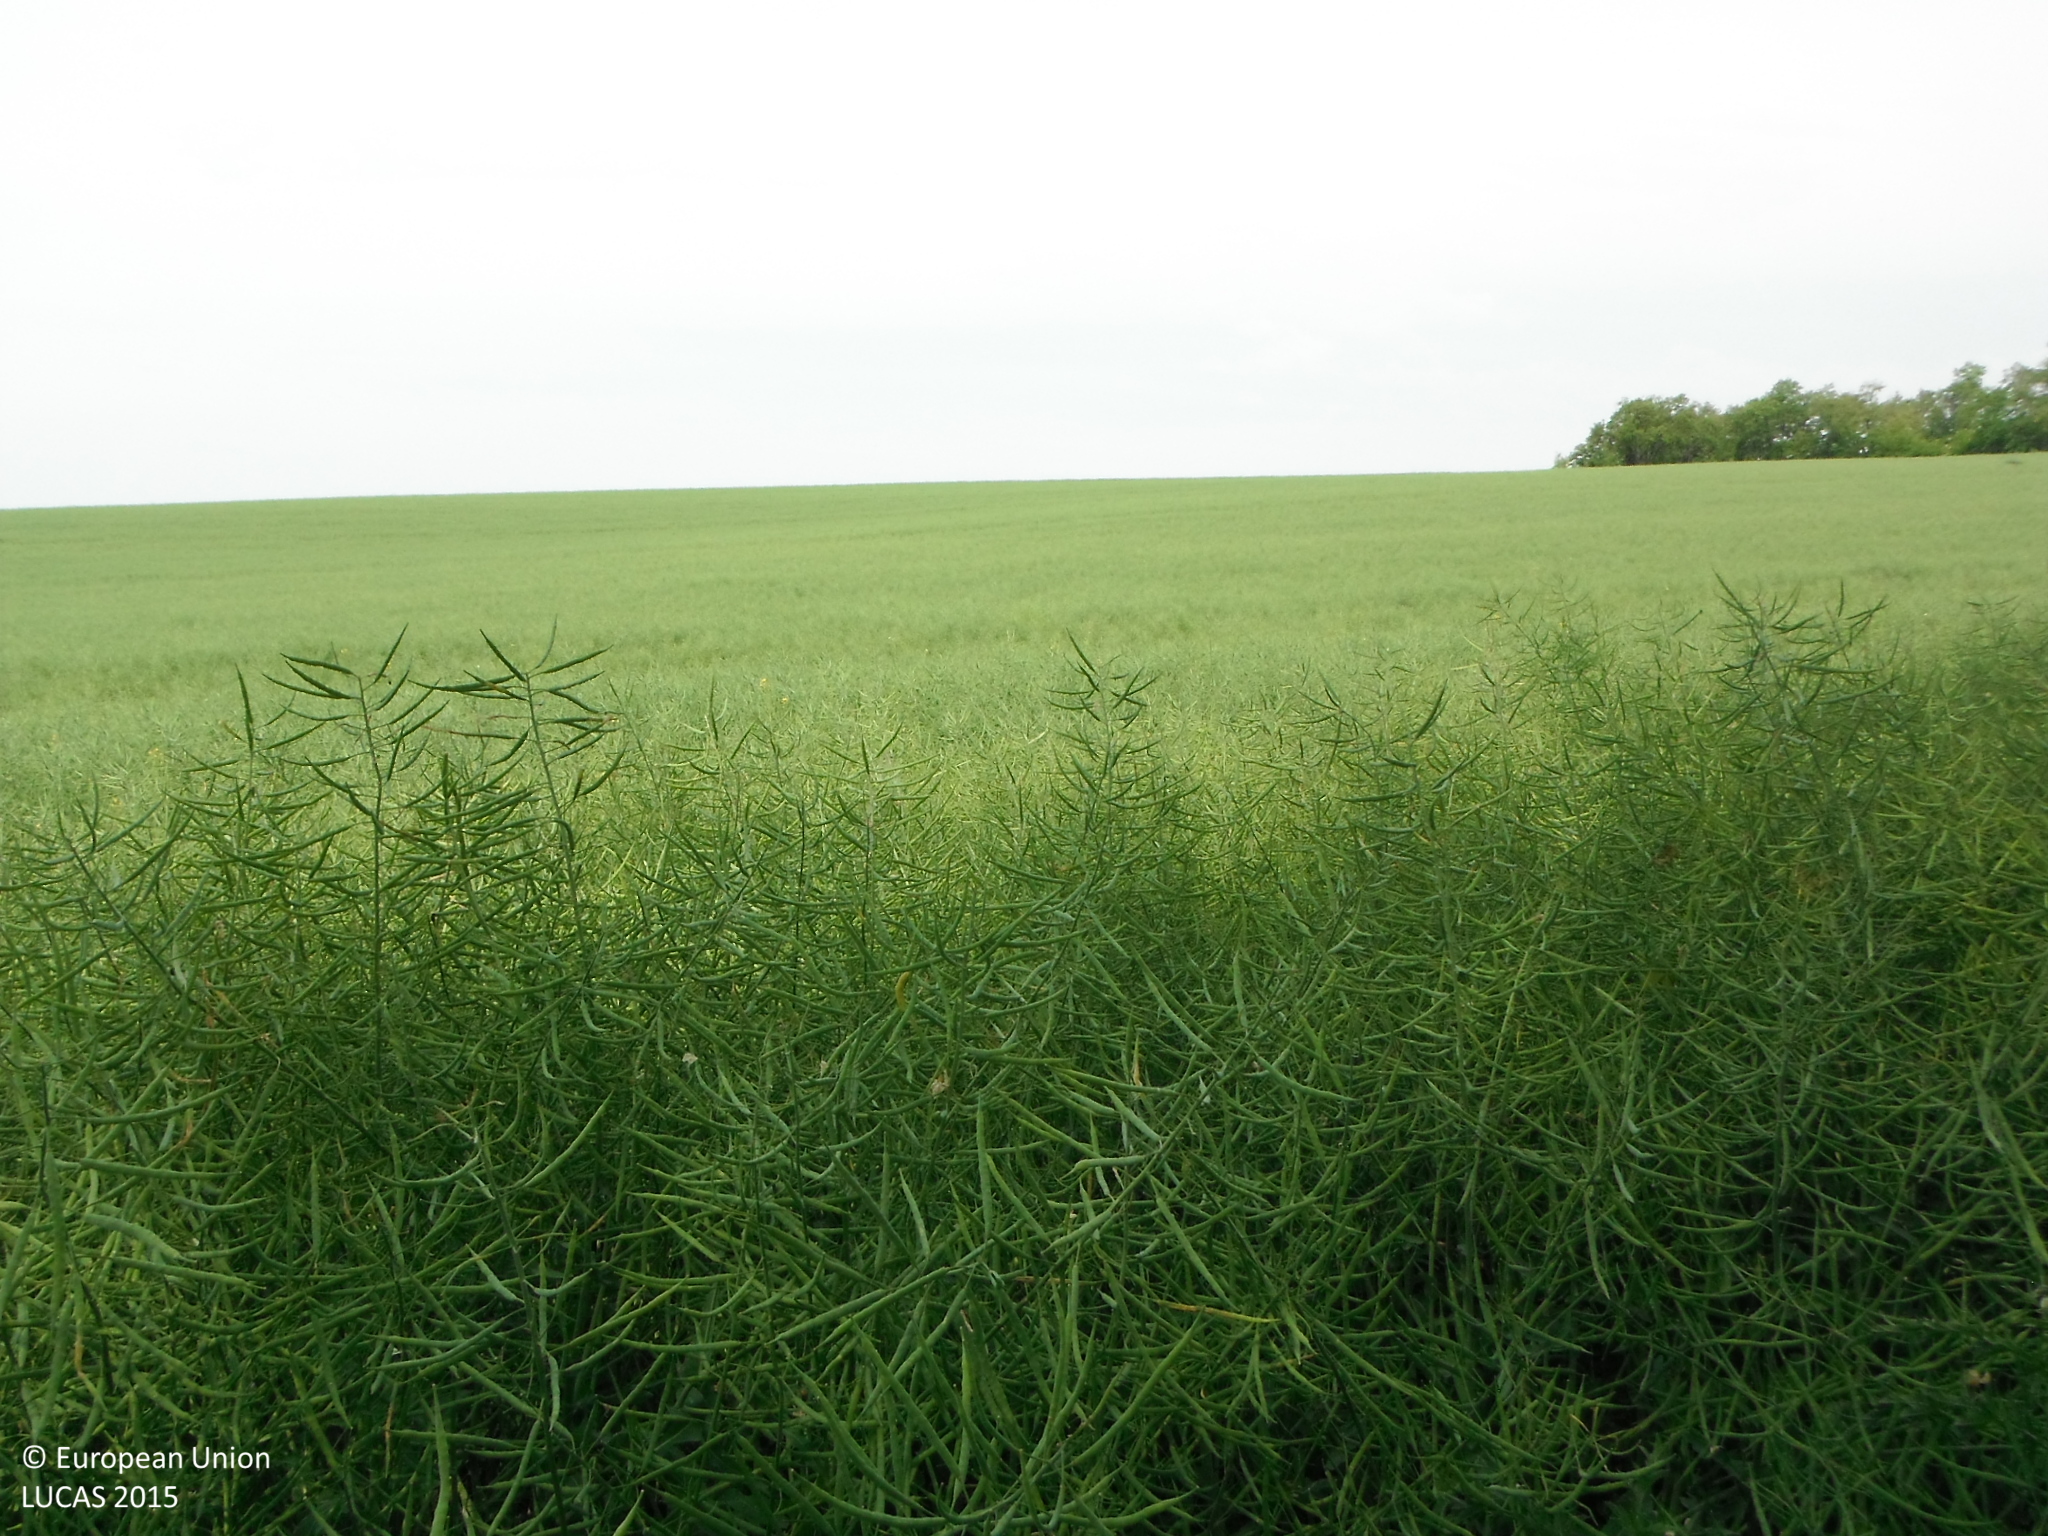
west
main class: Cropland
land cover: Rape and turnip rape
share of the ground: > 75 %
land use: Agriculture (excluding fallow land and kitchen gardens)
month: June
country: SK
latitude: 48.2381
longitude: 18.2684
